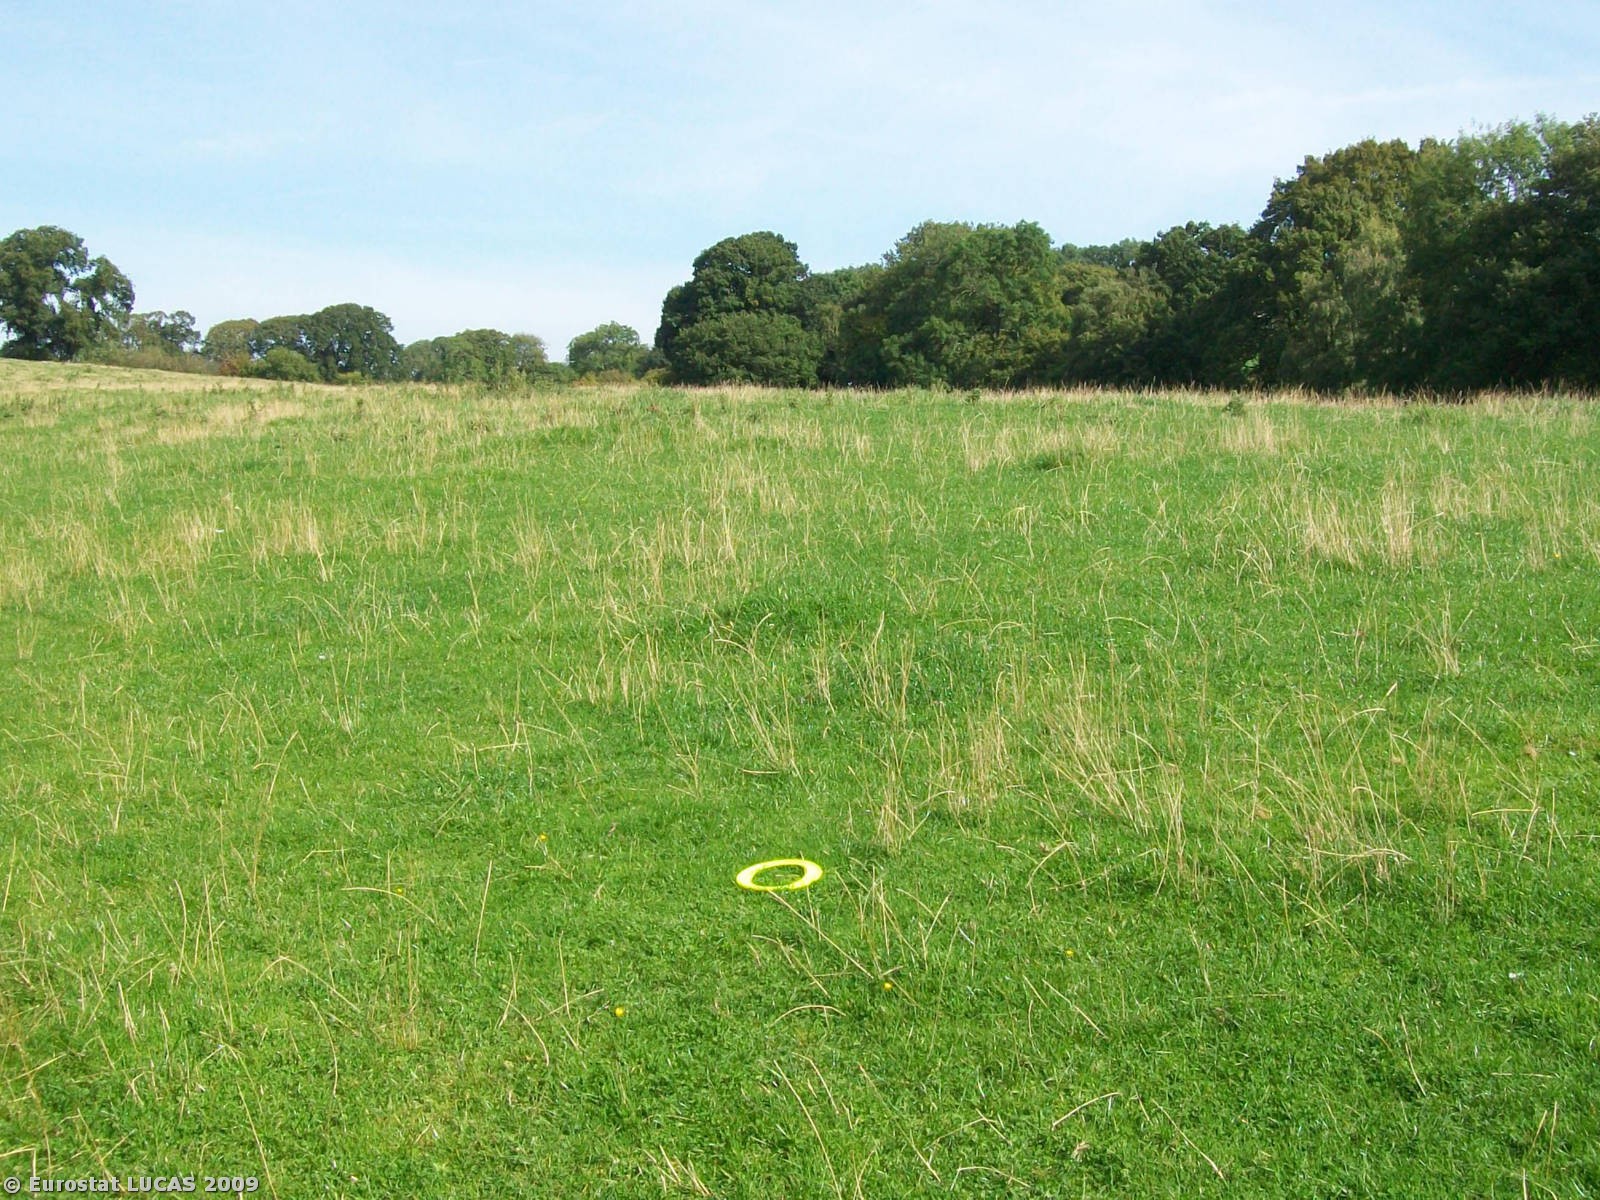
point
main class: Grassland
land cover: Grassland without tree/shrub cover
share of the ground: > 75 %
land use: Agriculture (excluding fallow land and kitchen gardens)
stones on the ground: < 10 %
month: September
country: GB
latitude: 52.2652
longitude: -2.4470
